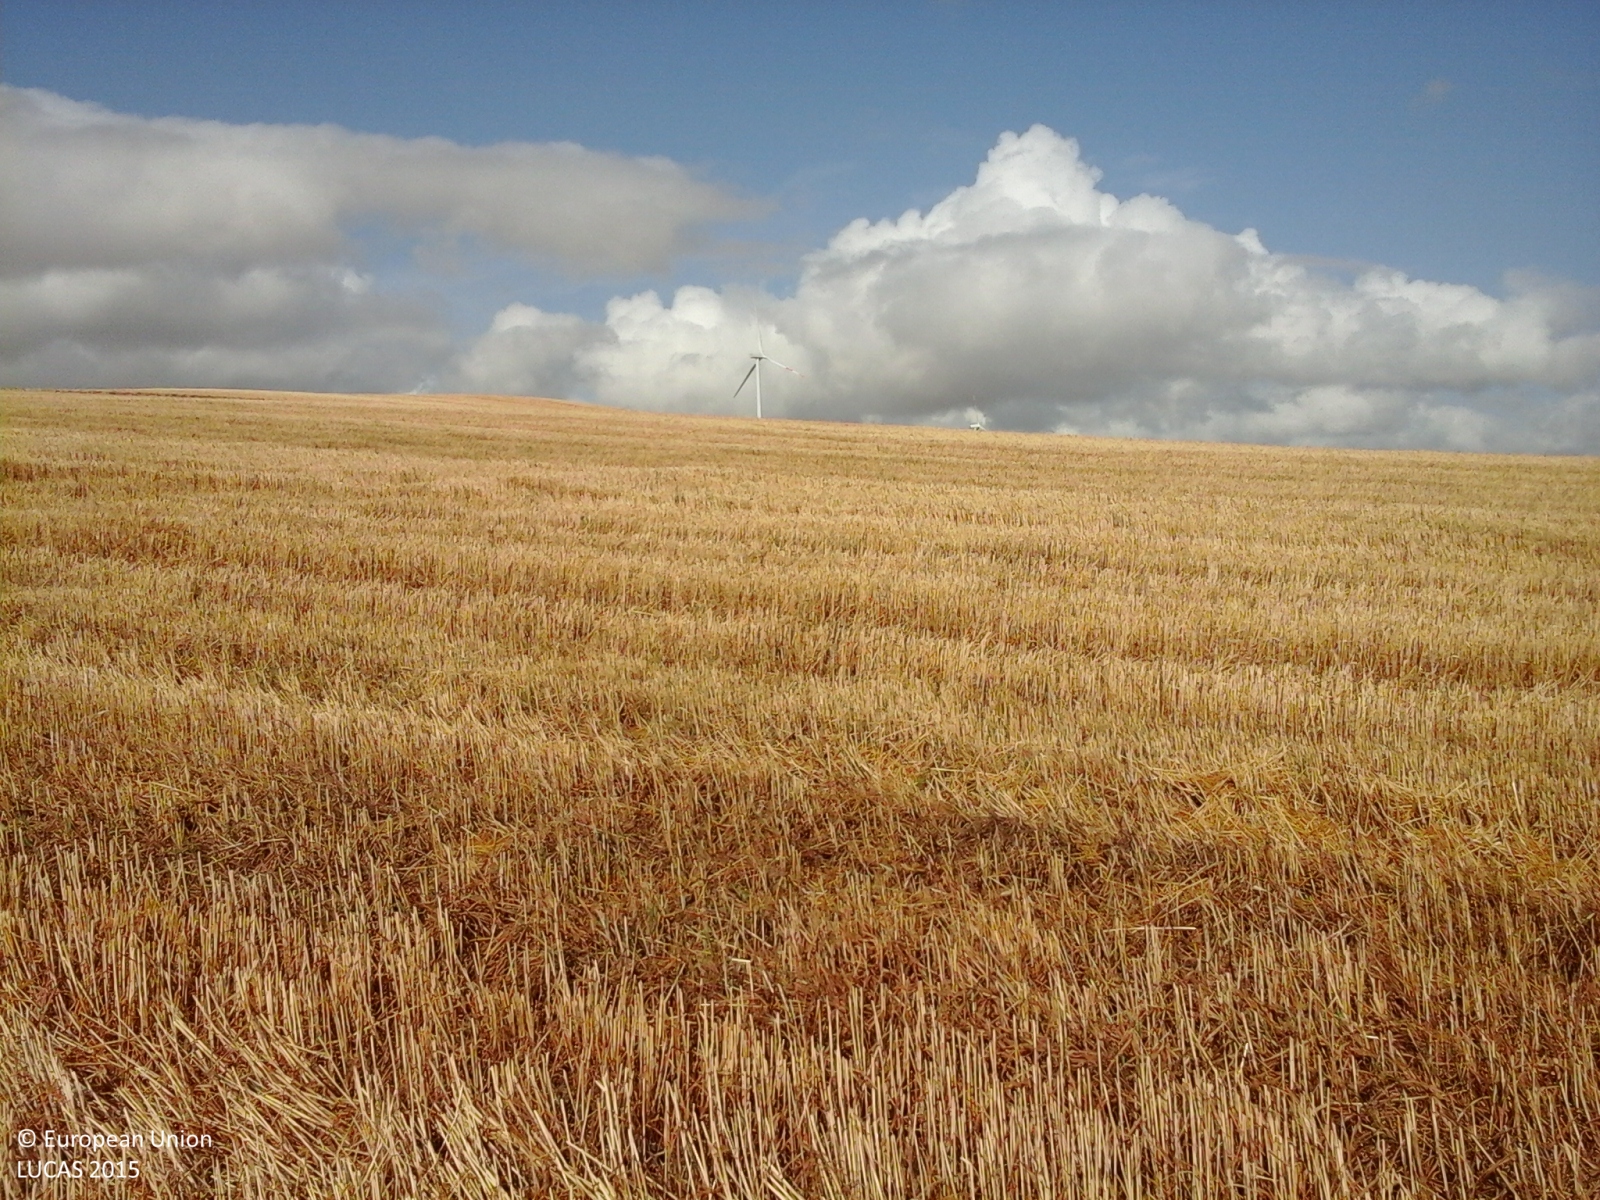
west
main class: Cropland
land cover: Durum wheat
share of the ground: > 75 %
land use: Agriculture (excluding fallow land and kitchen gardens)
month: June
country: IT
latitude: 41.8041
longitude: 15.0511
